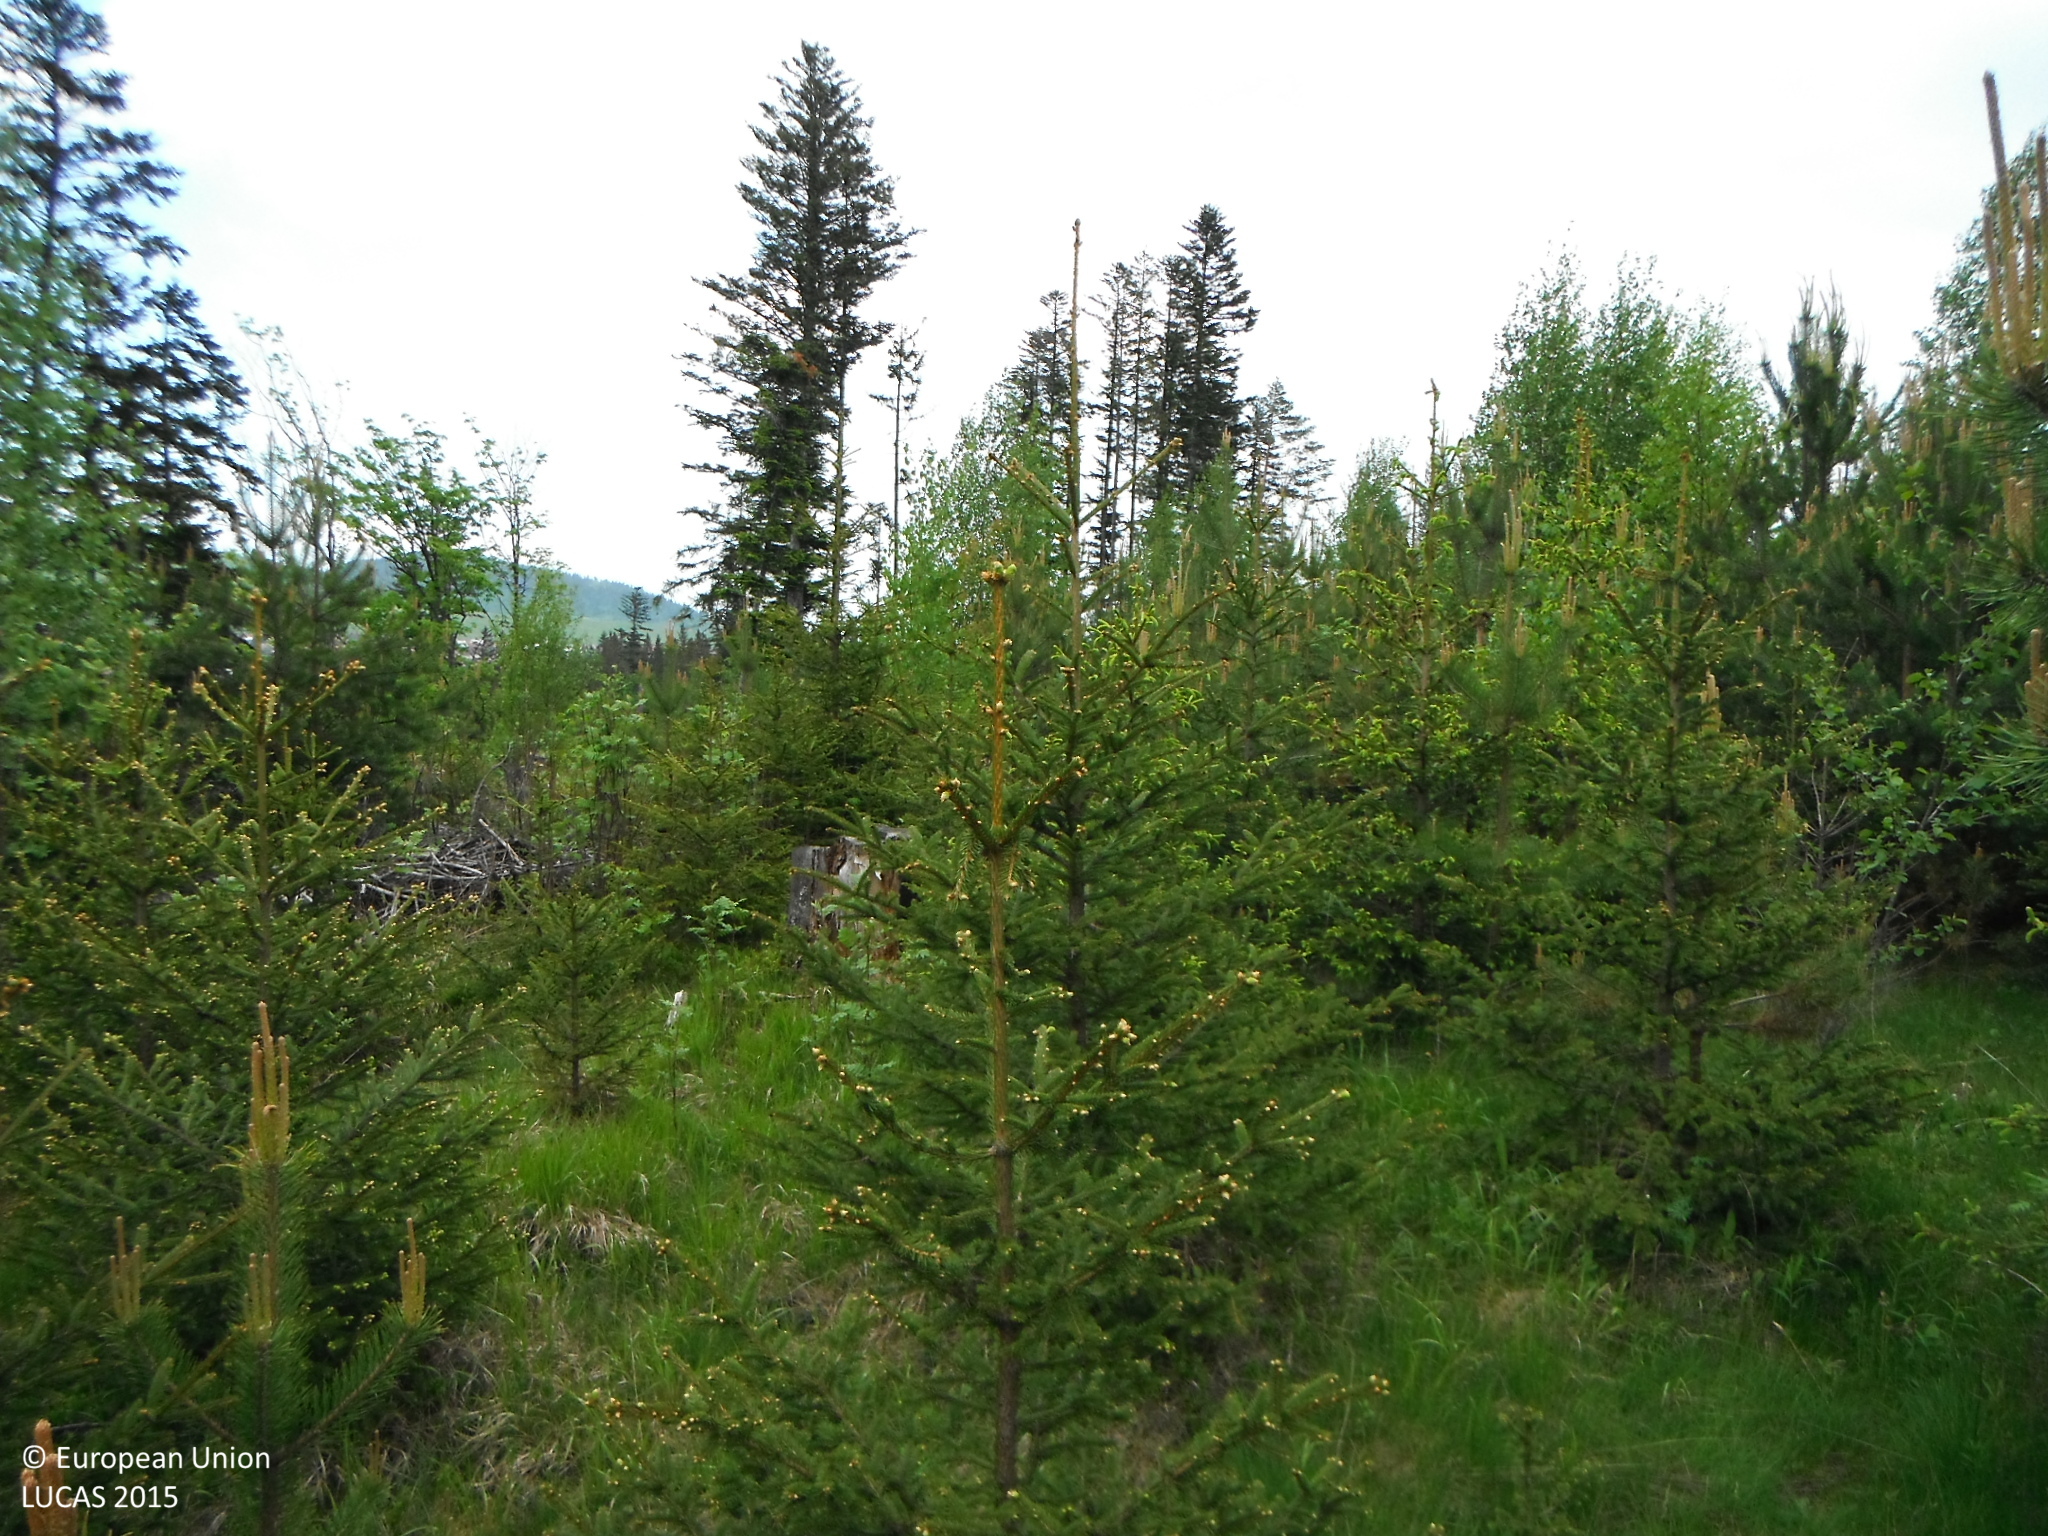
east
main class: Woodland
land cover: Pine dominated mixed woodland
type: alpine coniferous forest
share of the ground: > 75 %
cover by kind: coniferous forest trees 50 %, broadleaved forest trees 25 %, herbaceous plants 15 %, lichens and mosses 5 %, consolidated bare surface 5 %
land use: Forestry
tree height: < 5 m
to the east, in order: Pine dominated mixed woodland; Spontaneously vegetated surfaces; Ditches and canals; Spruce dominated mixed woodland; Grassland without tree/shrub cover
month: May
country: SK
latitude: 49.2227
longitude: 20.3462
